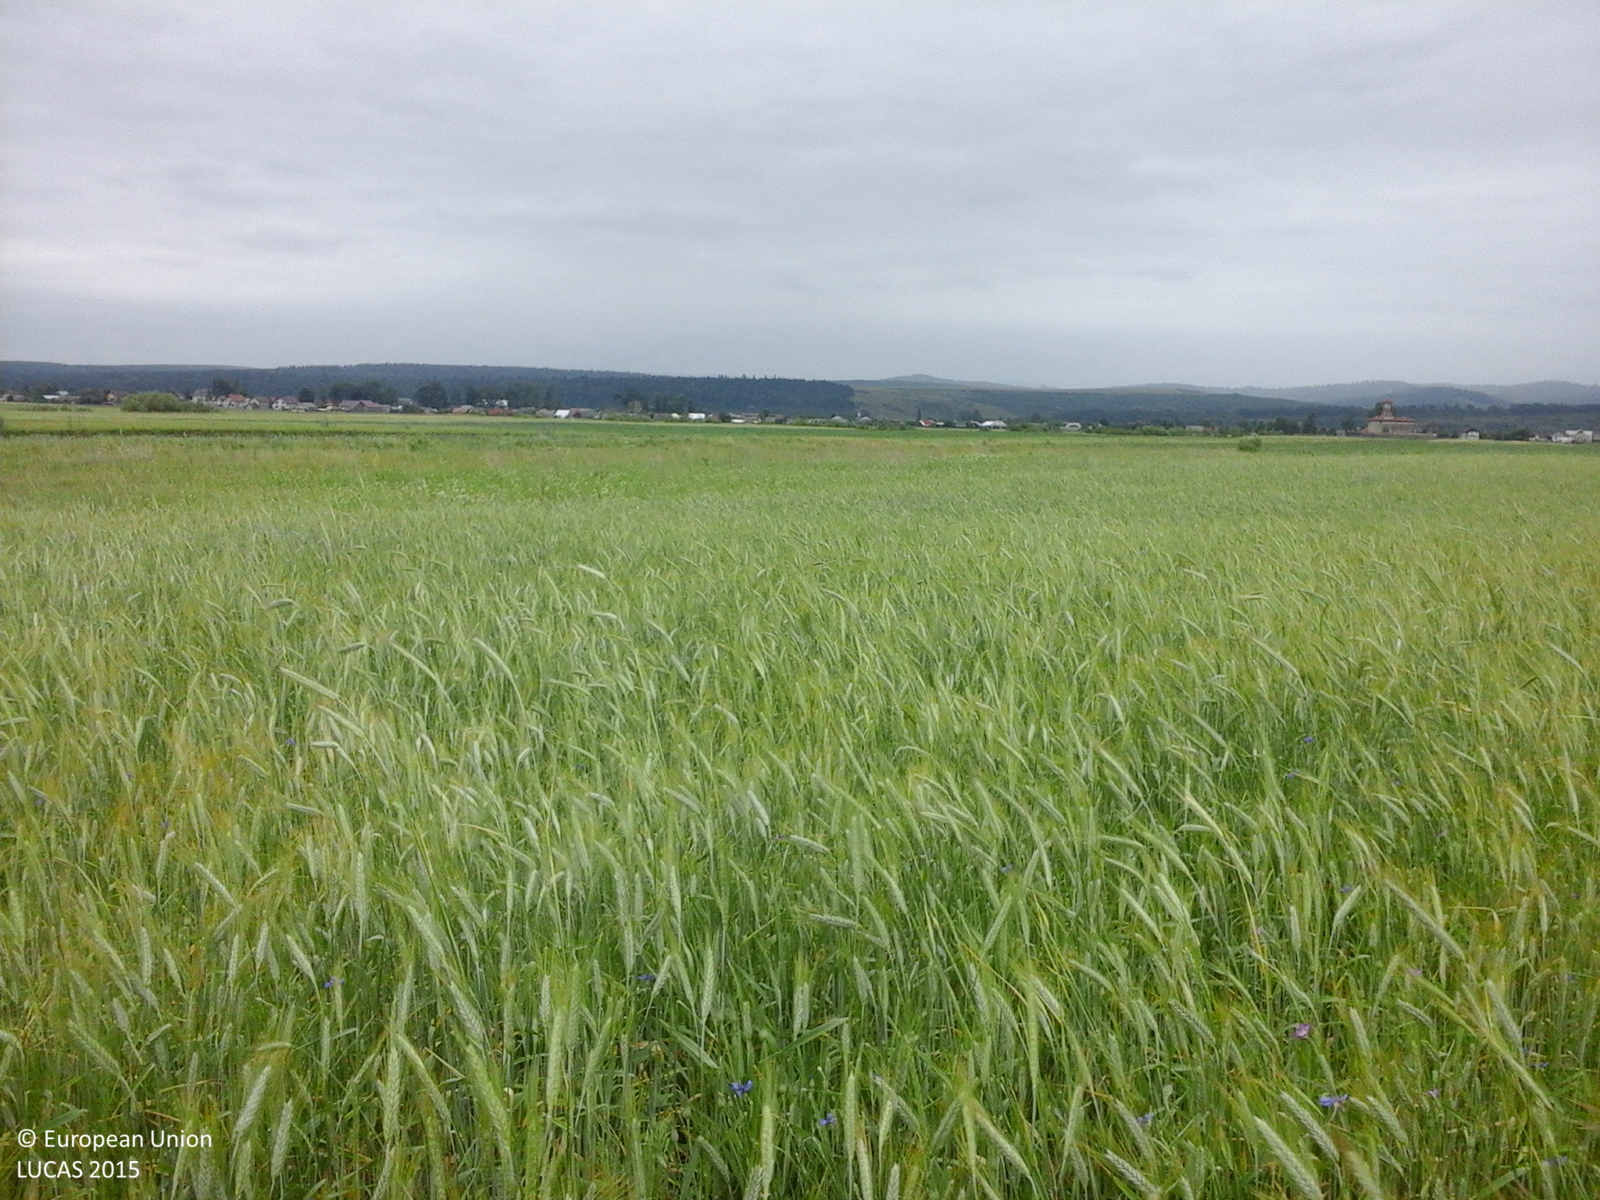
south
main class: Cropland
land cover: Common wheat
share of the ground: > 75 %
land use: Agriculture (excluding fallow land and kitchen gardens)
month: June
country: RO
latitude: 47.4343
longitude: 26.2167
